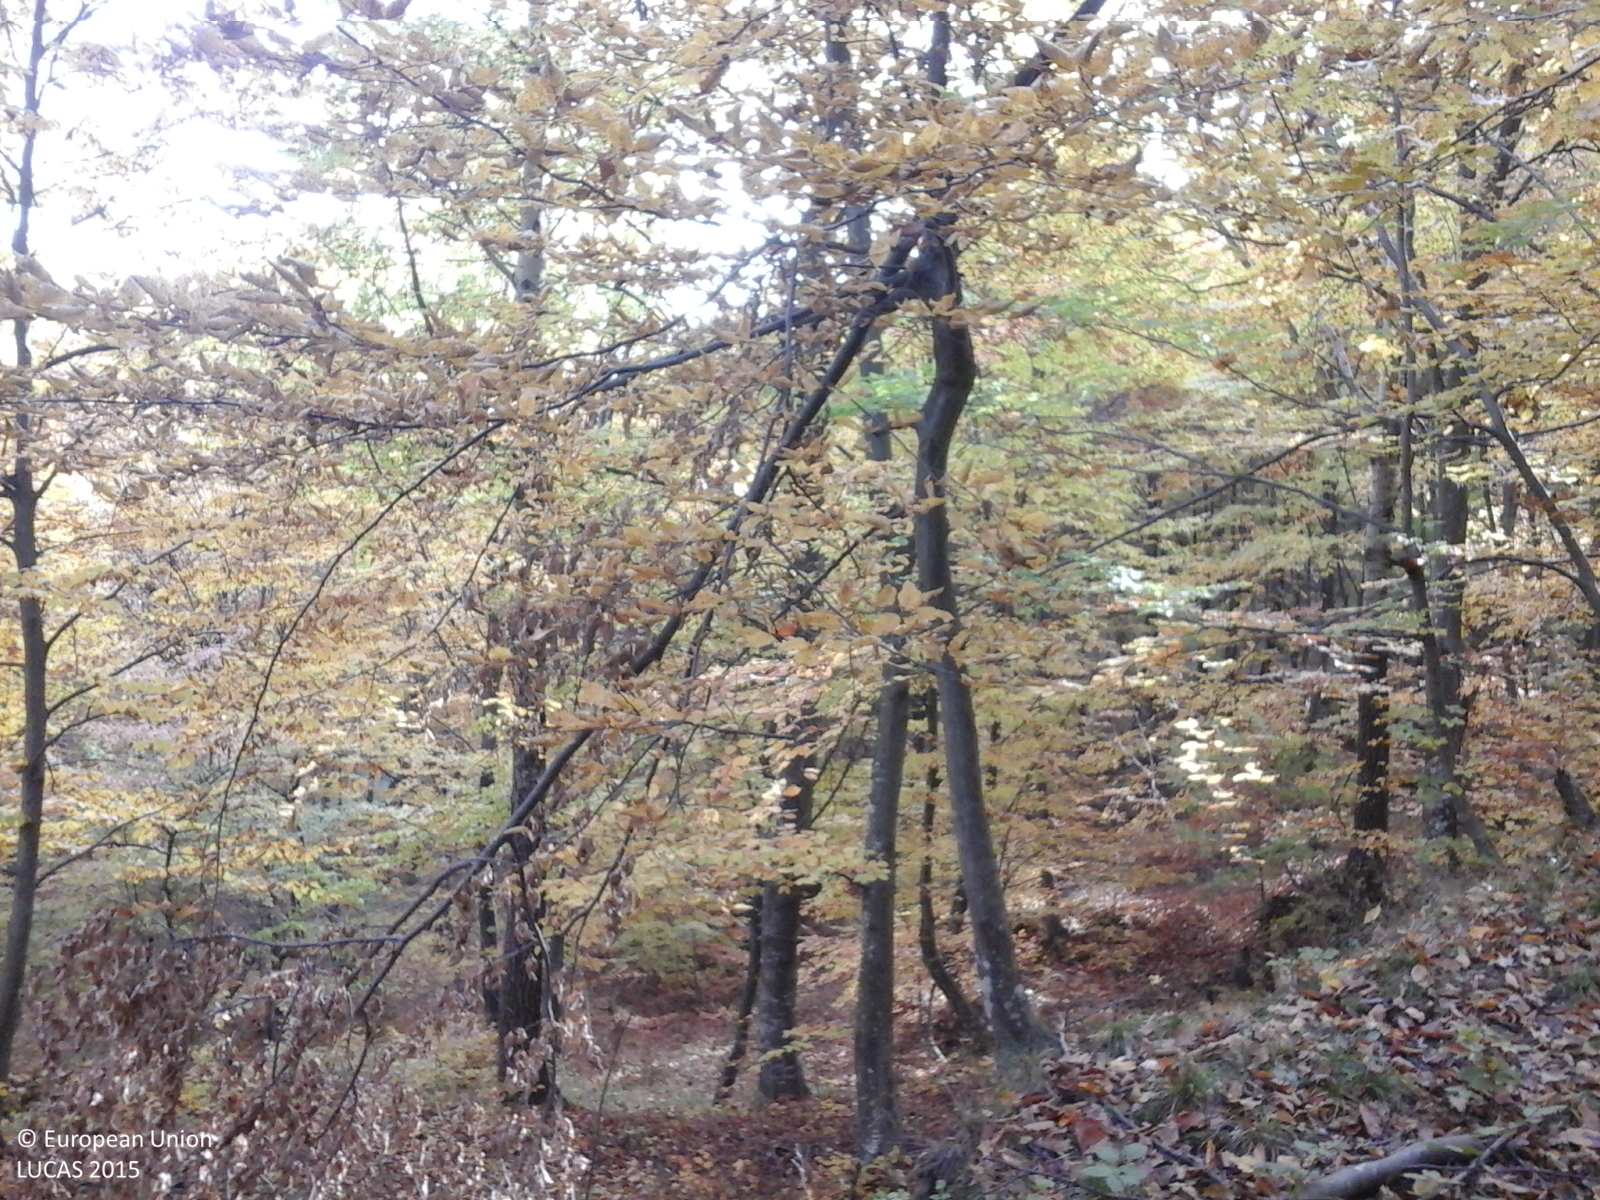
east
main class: Woodland
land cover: Broadleaved woodland
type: beech forest
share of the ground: > 75 %
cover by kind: broadleaved forest trees 100 %
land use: Forestry
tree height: > 5 m
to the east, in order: Broadleaved woodland
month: October
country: RO
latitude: 45.6378
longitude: 27.0108
